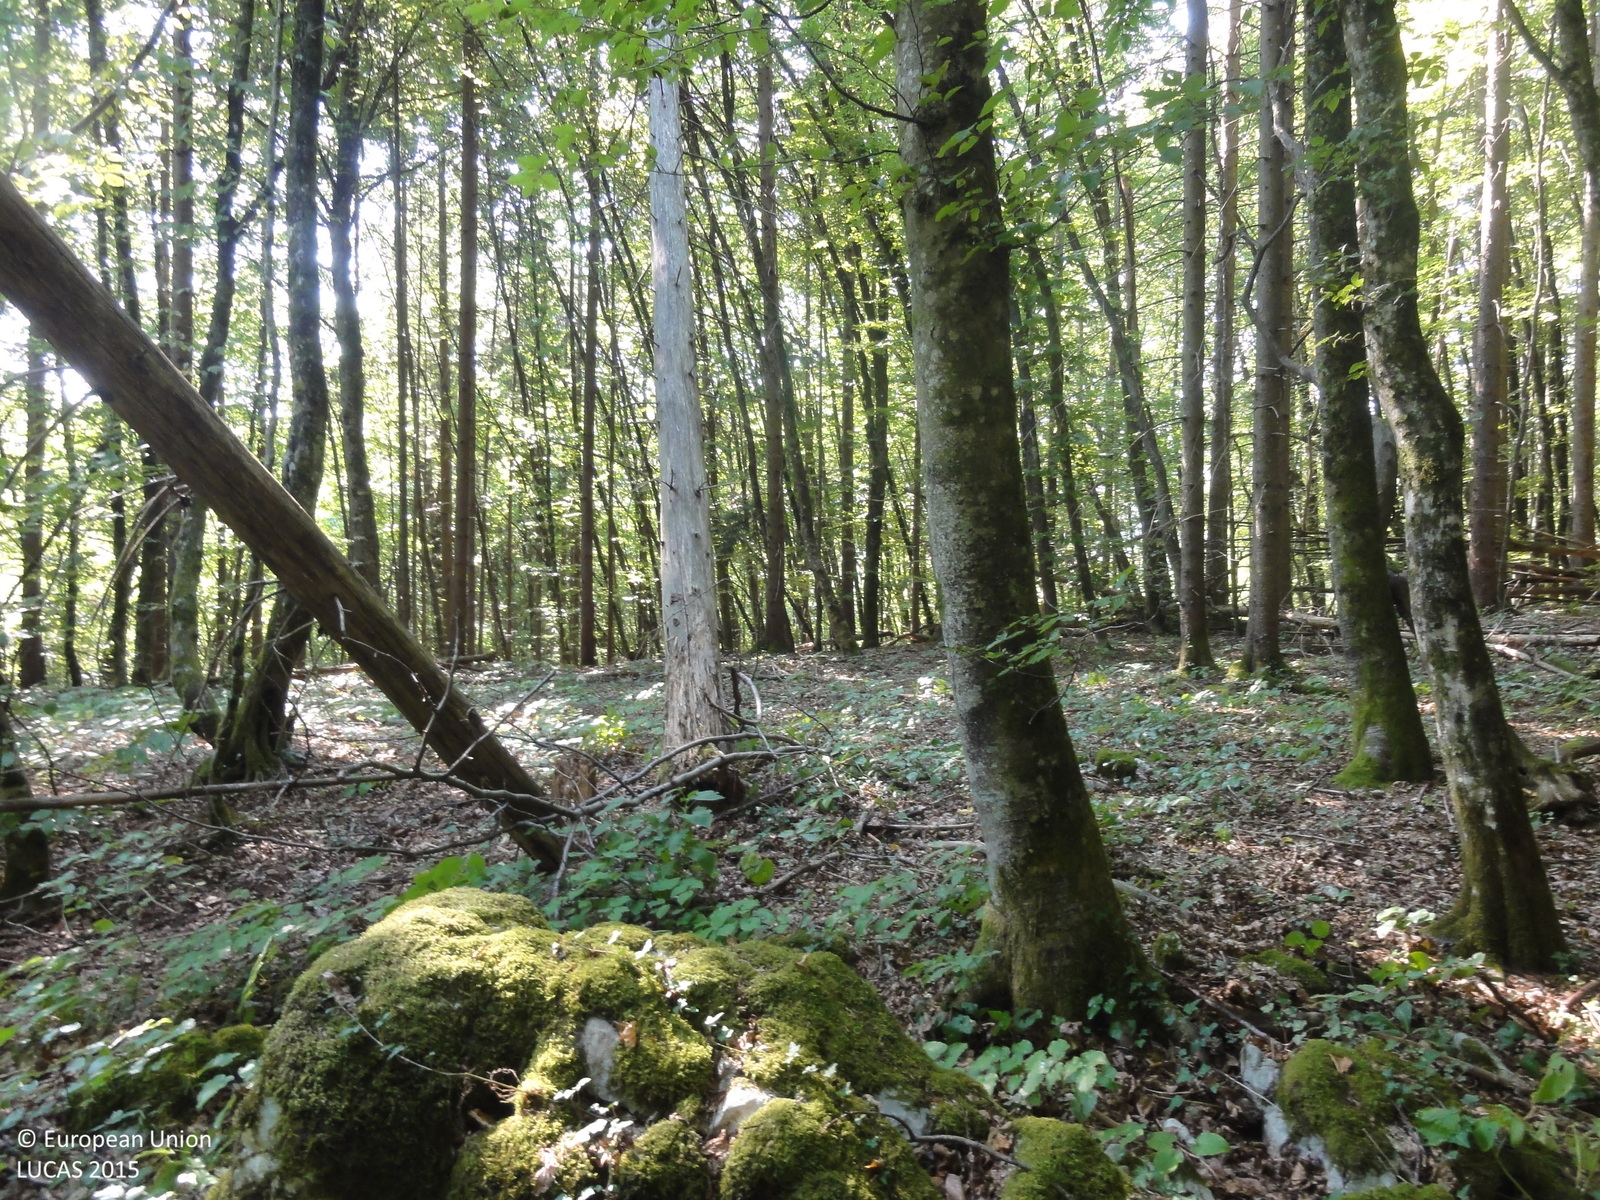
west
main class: Woodland
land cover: Broadleaved woodland
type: beech forest
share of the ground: > 75 %
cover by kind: broadleaved forest trees 85 %, coniferous forest trees 15 %
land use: Forestry
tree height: > 5 m
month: August
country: SI
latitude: 45.8346
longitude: 15.0560
